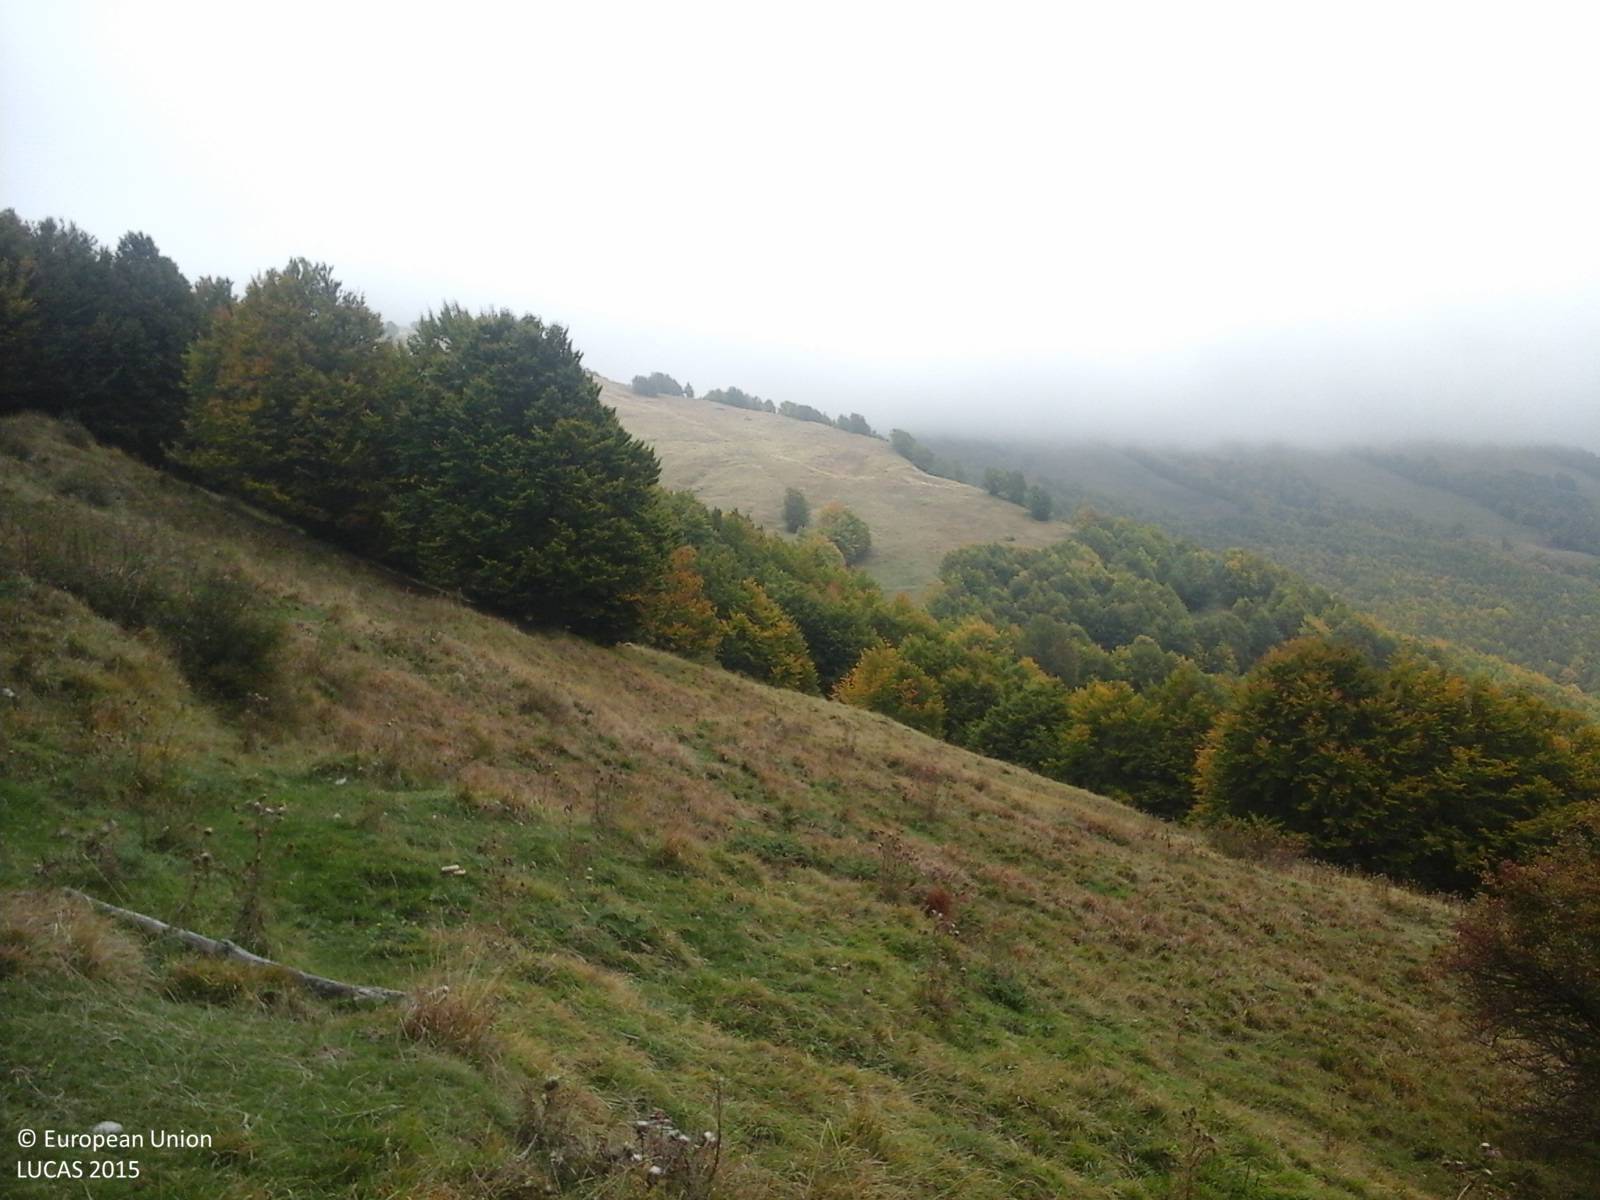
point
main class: Woodland
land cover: Broadleaved woodland
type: mountainous beech forest
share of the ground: > 75 %
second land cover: Grassland without tree/shrub cover
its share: > 75 %
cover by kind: broadleaved forest trees 100 %
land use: Forestry
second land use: Agriculture (excluding fallow land and kitchen gardens)
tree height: > 5 m
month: October
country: IT
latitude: 42.6899
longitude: 13.3221
